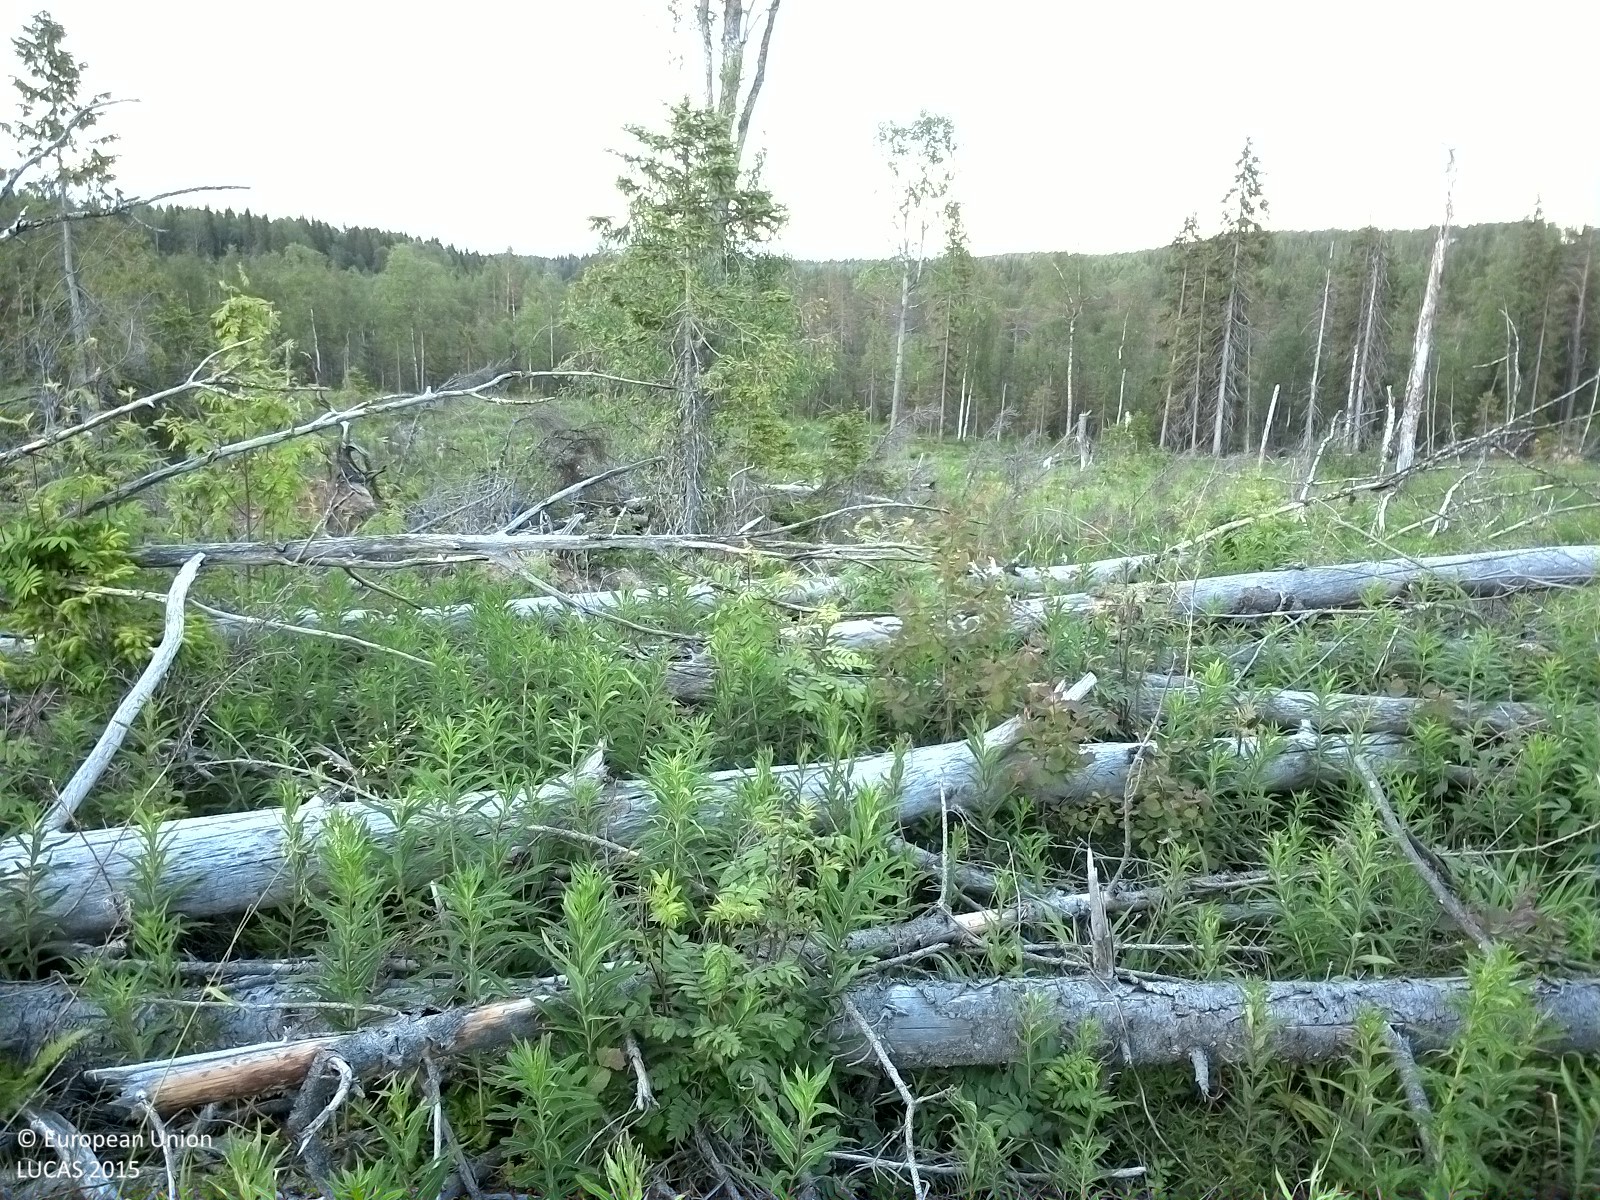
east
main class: Woodland
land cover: Broadleaved woodland
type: boreal forest
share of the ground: 10 - 25 %
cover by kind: herbaceous plants 65 %, unconsolidated bare surface 20 %, broadleaved forest trees 15 %
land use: Forestry
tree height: < 5 m
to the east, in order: Broadleaved woodland; Shrubland without tree cover; Spruce dominated mixed woodland; Shrubland with sparse tree cover; Other mixed woodland
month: July
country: SE
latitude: 62.1889
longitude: 16.7630
